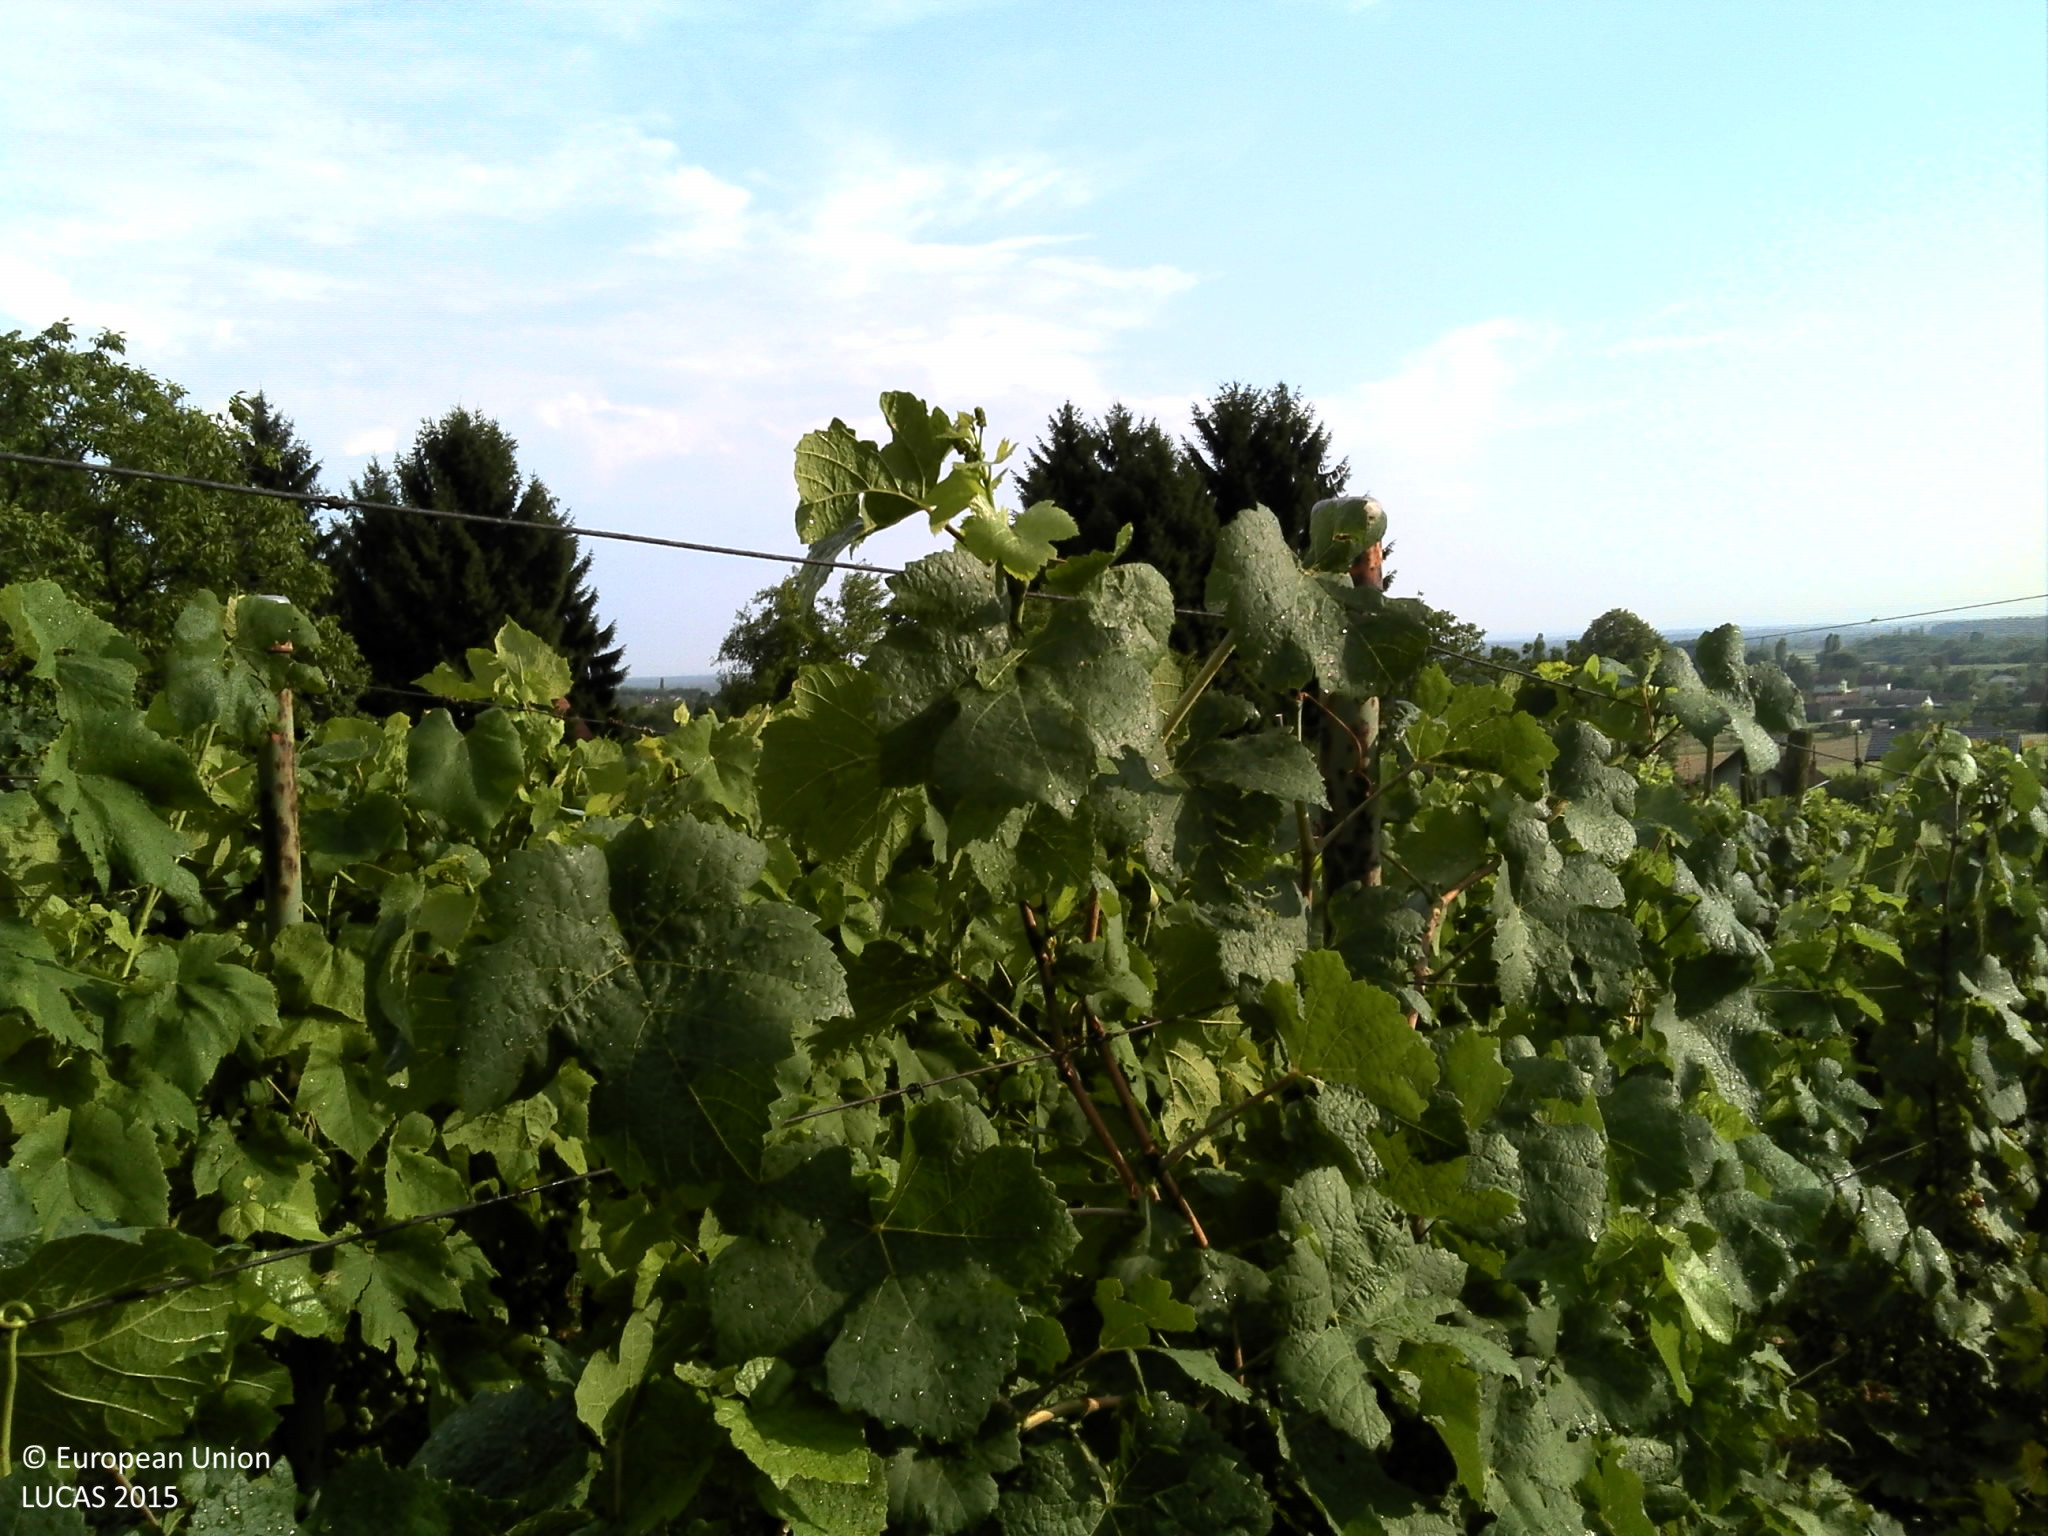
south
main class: Cropland
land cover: Vineyards
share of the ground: 50 - 75 %
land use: Agriculture (excluding fallow land and kitchen gardens)
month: July
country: HR
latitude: 45.5268
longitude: 16.6952
